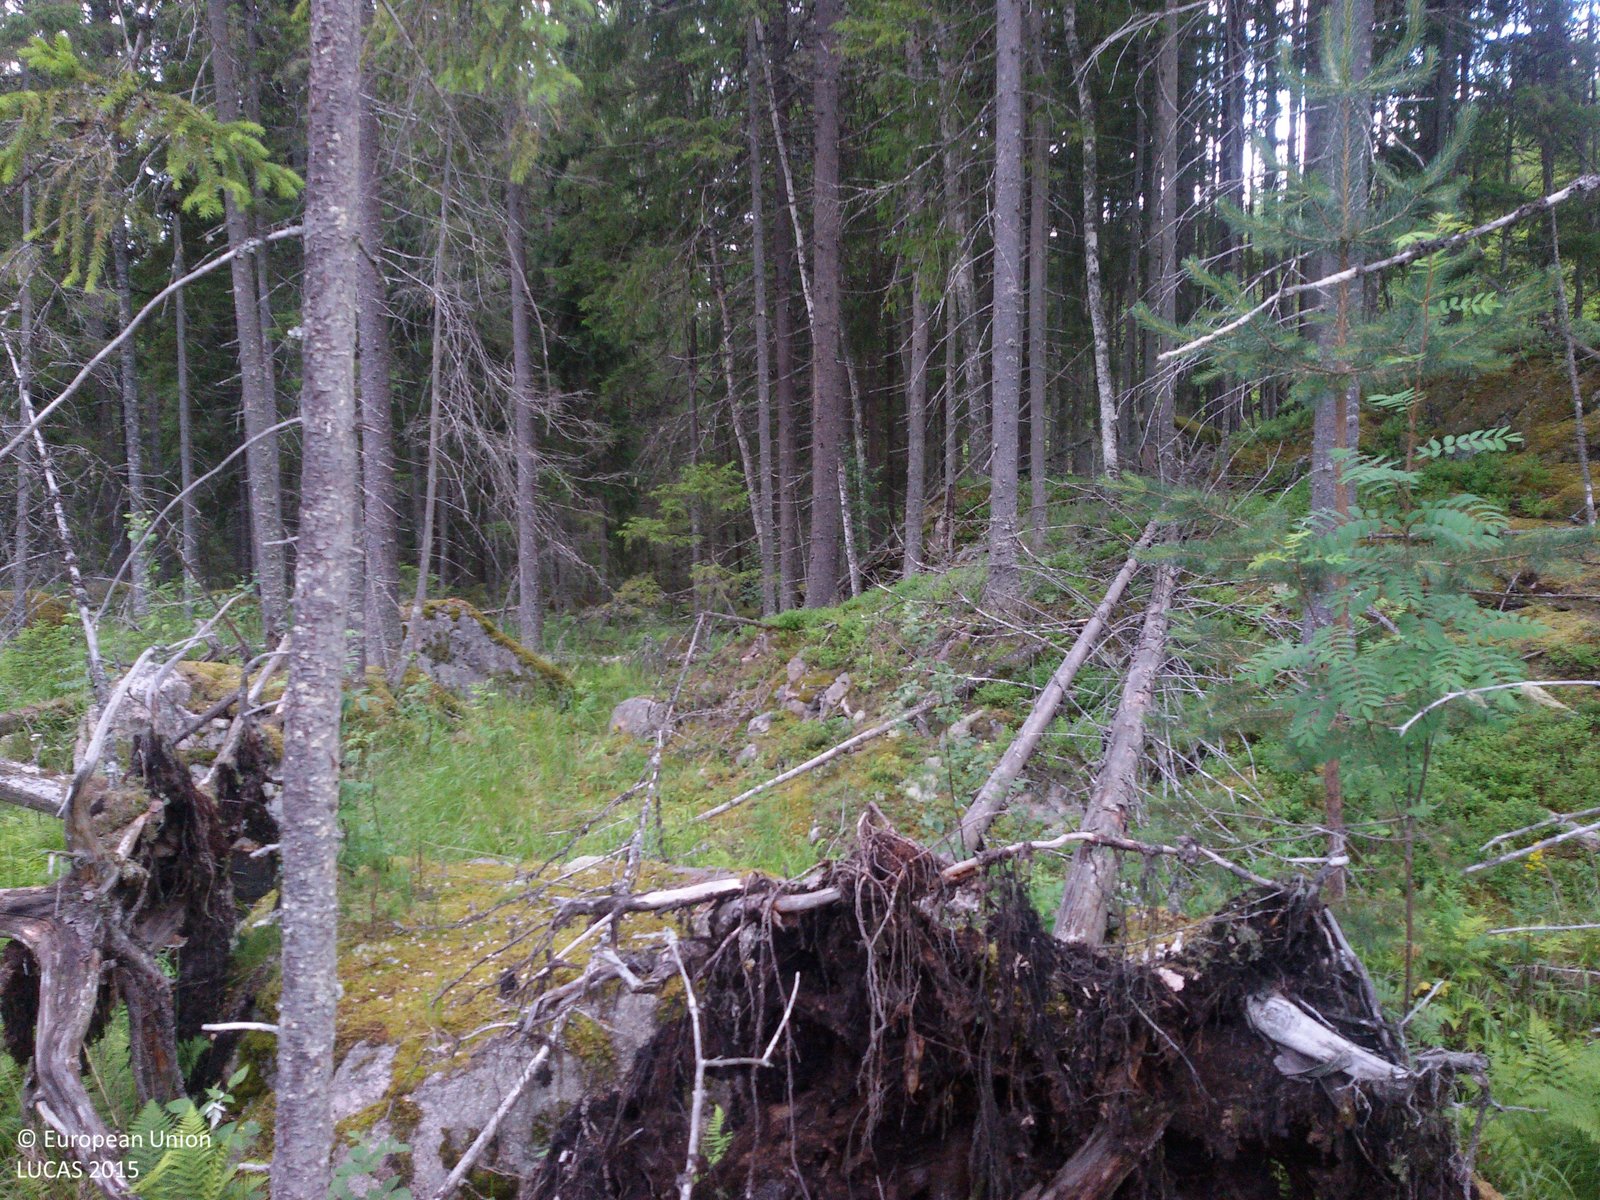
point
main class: Woodland
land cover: Spruce dominated coniferous woodland
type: boreal forest
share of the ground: 50 - 75 %
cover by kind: coniferous forest trees 75 %, shrubs 15 %, herbaceous plants 10 %
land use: Forestry
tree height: > 5 m
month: July
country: SE
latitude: 60.4008
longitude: 14.9431
